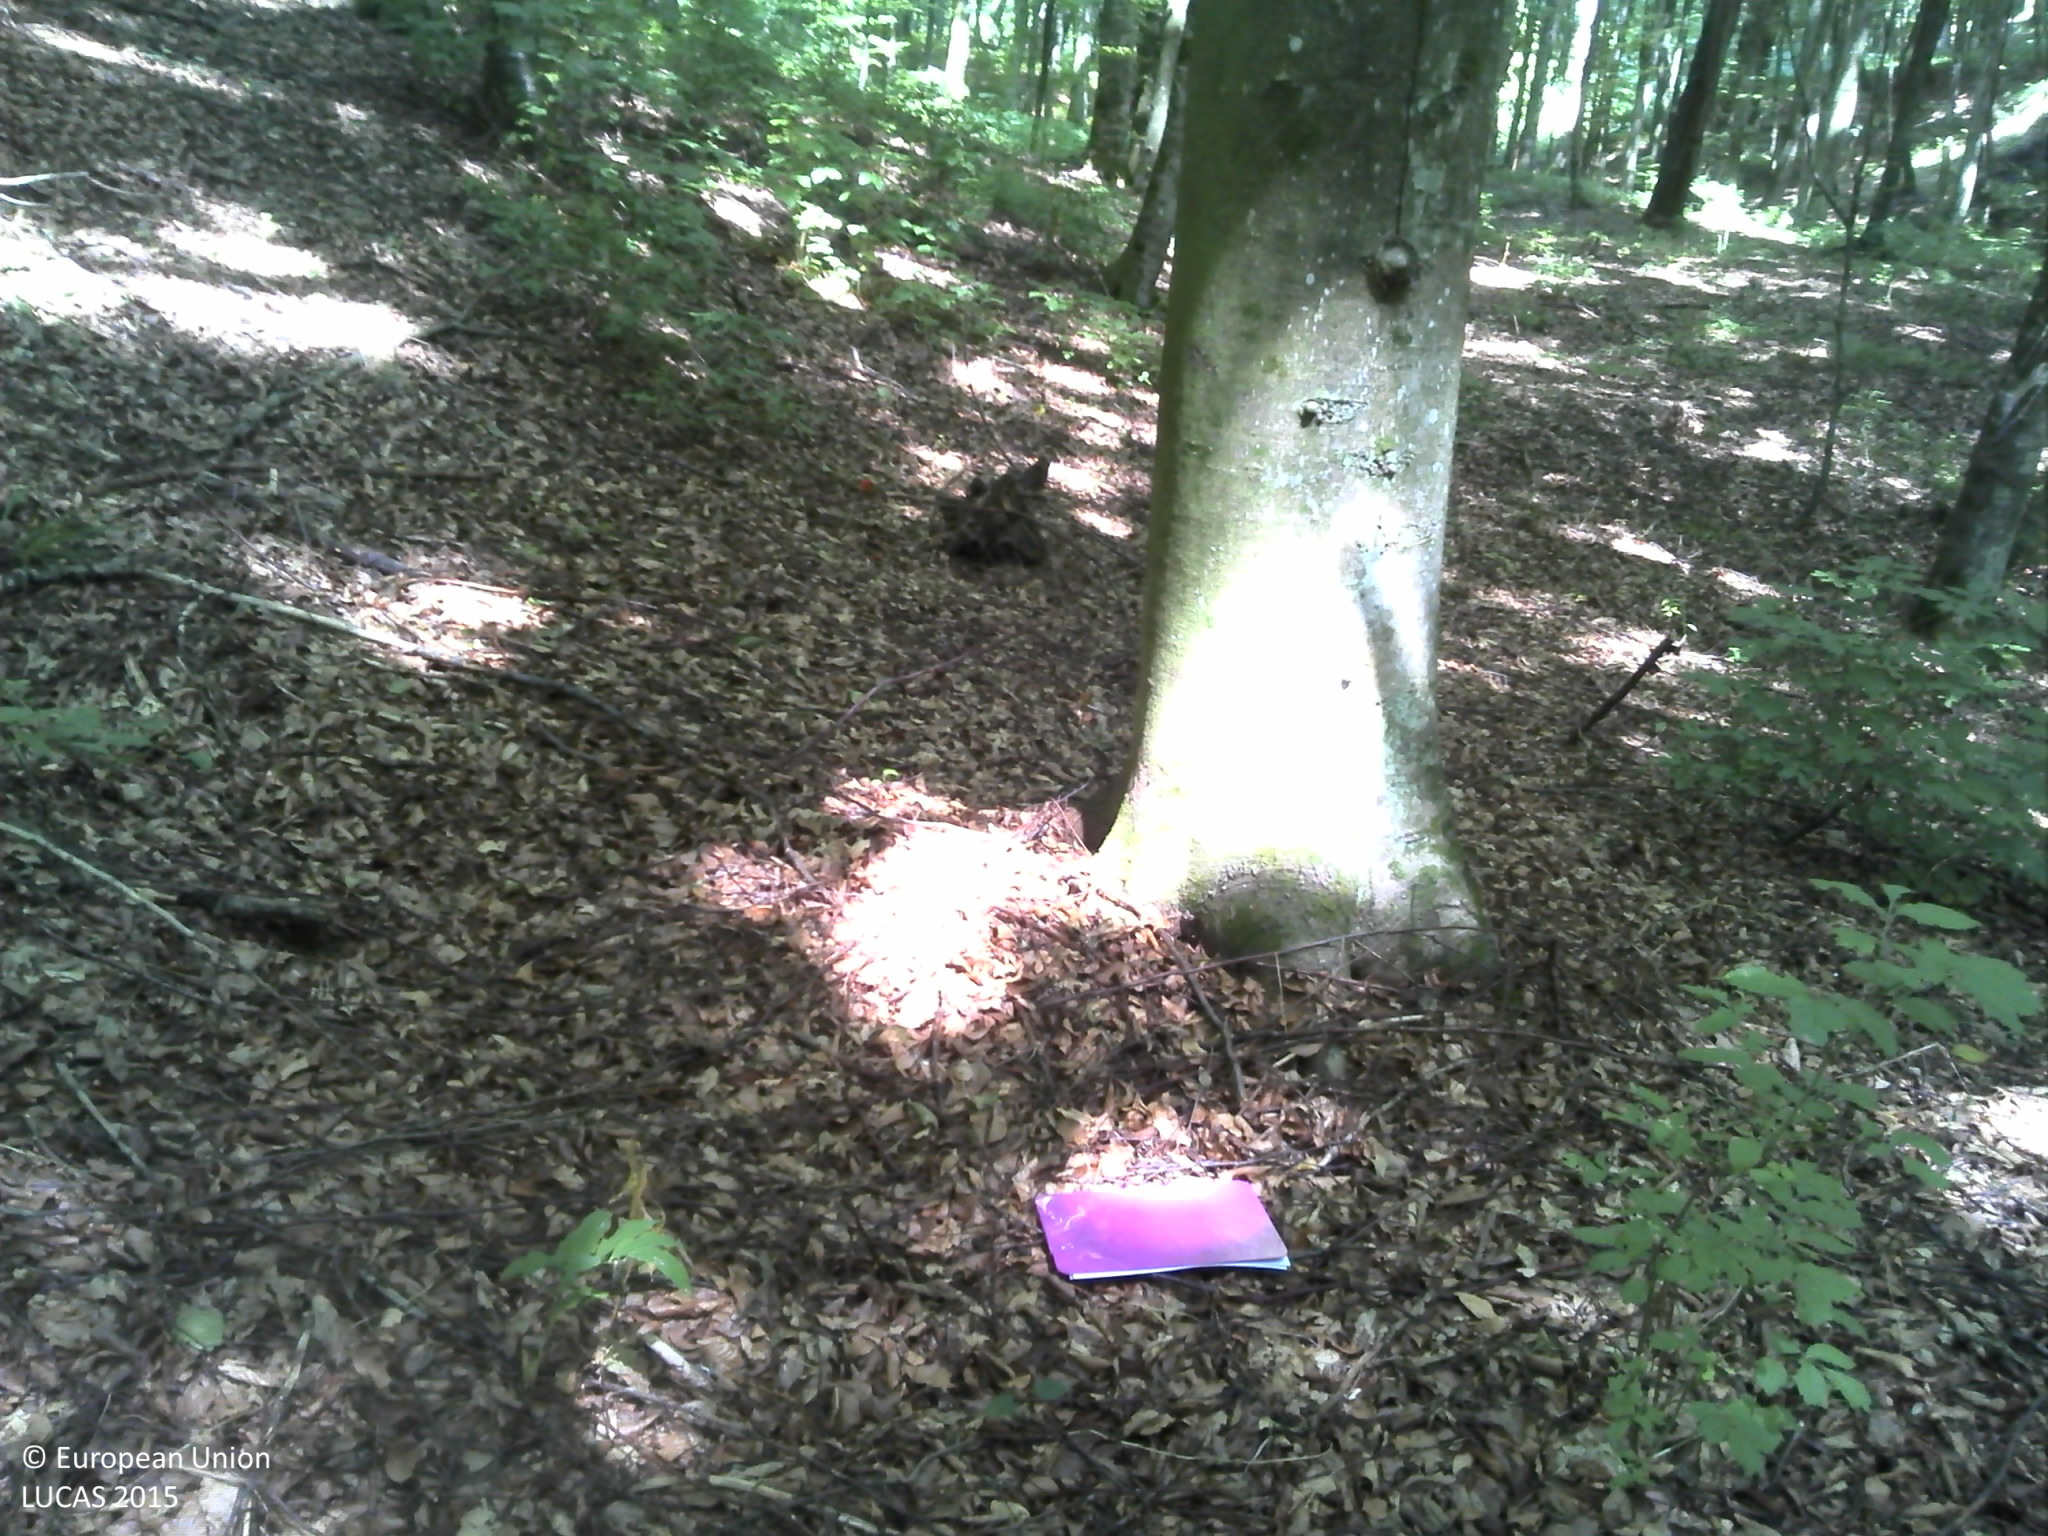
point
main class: Woodland
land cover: Broadleaved woodland
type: acidophilous oak and oak-birch forest
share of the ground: > 75 %
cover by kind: broadleaved forest trees 90 %, shrubs 5 %, herbaceous plants 5 %
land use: Forestry
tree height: > 5 m
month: July
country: HR
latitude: 45.5505
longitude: 17.1607
